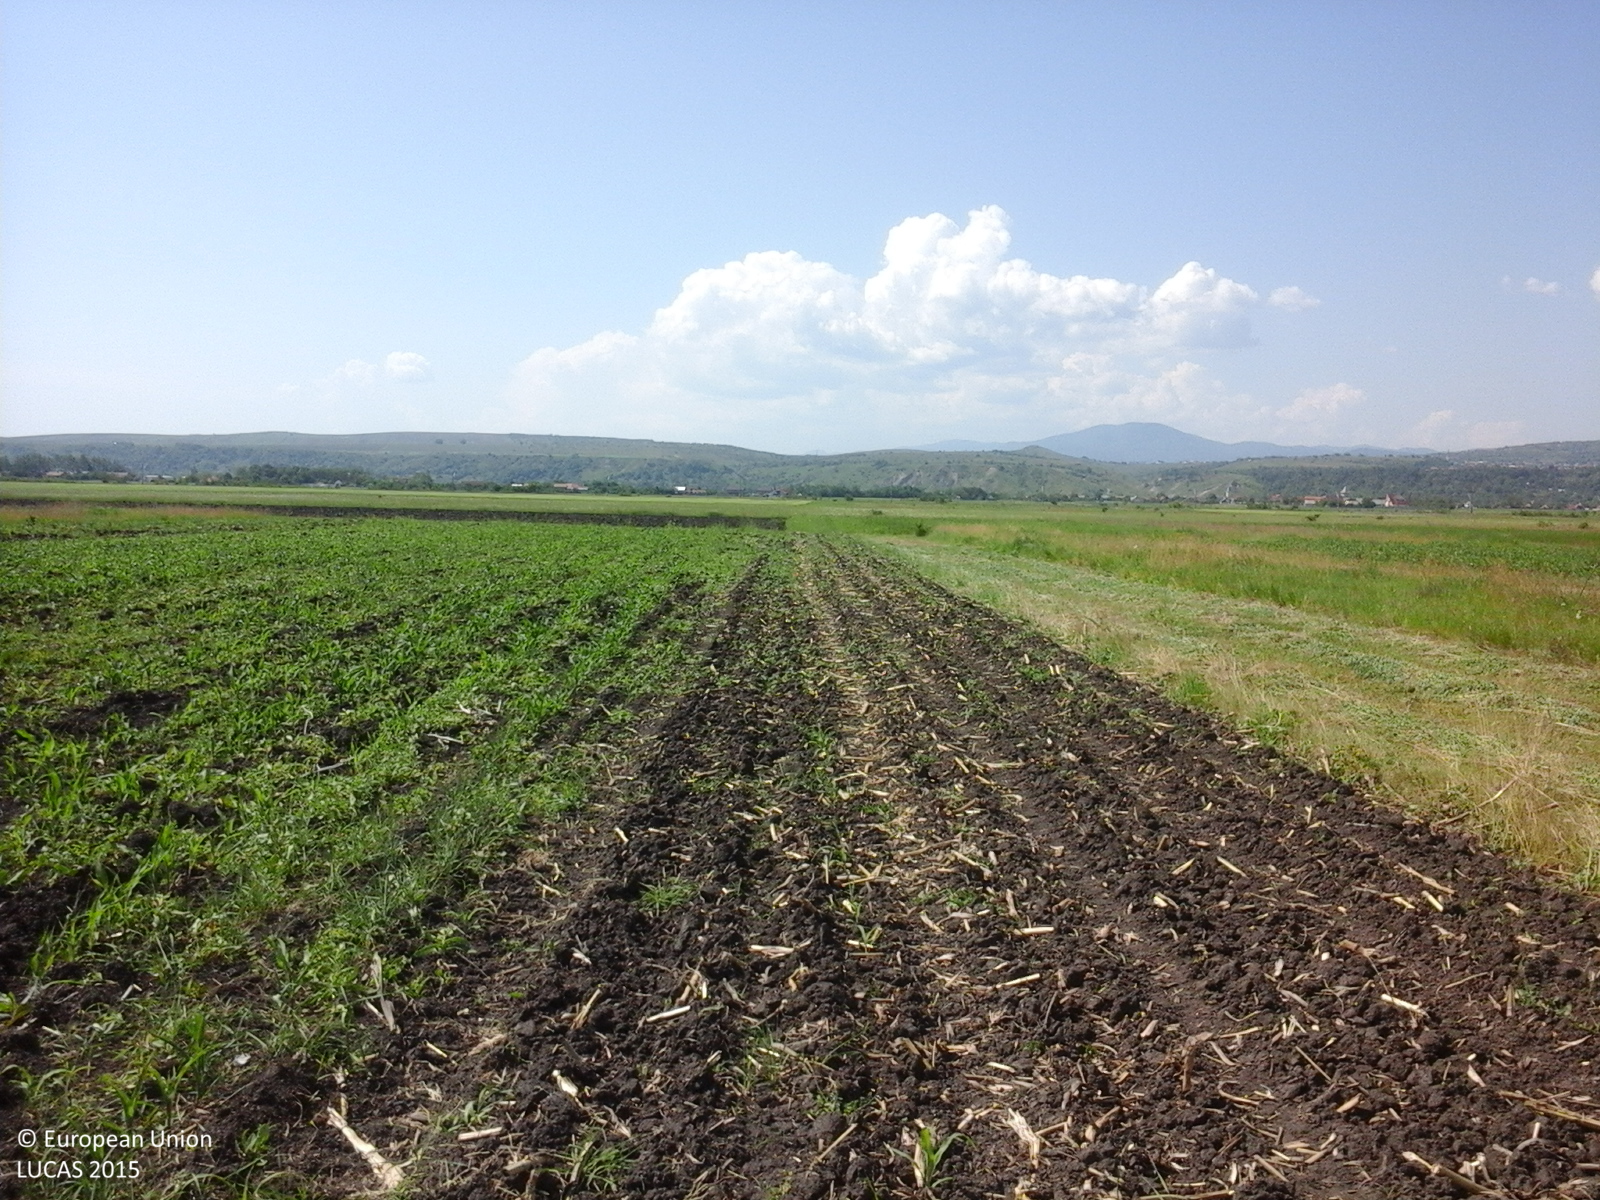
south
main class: Cropland
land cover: Maize
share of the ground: 10 - 25 %
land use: Agriculture (excluding fallow land and kitchen gardens)
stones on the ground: < 10 %
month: June
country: RO
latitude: 46.2786
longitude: 26.6839
